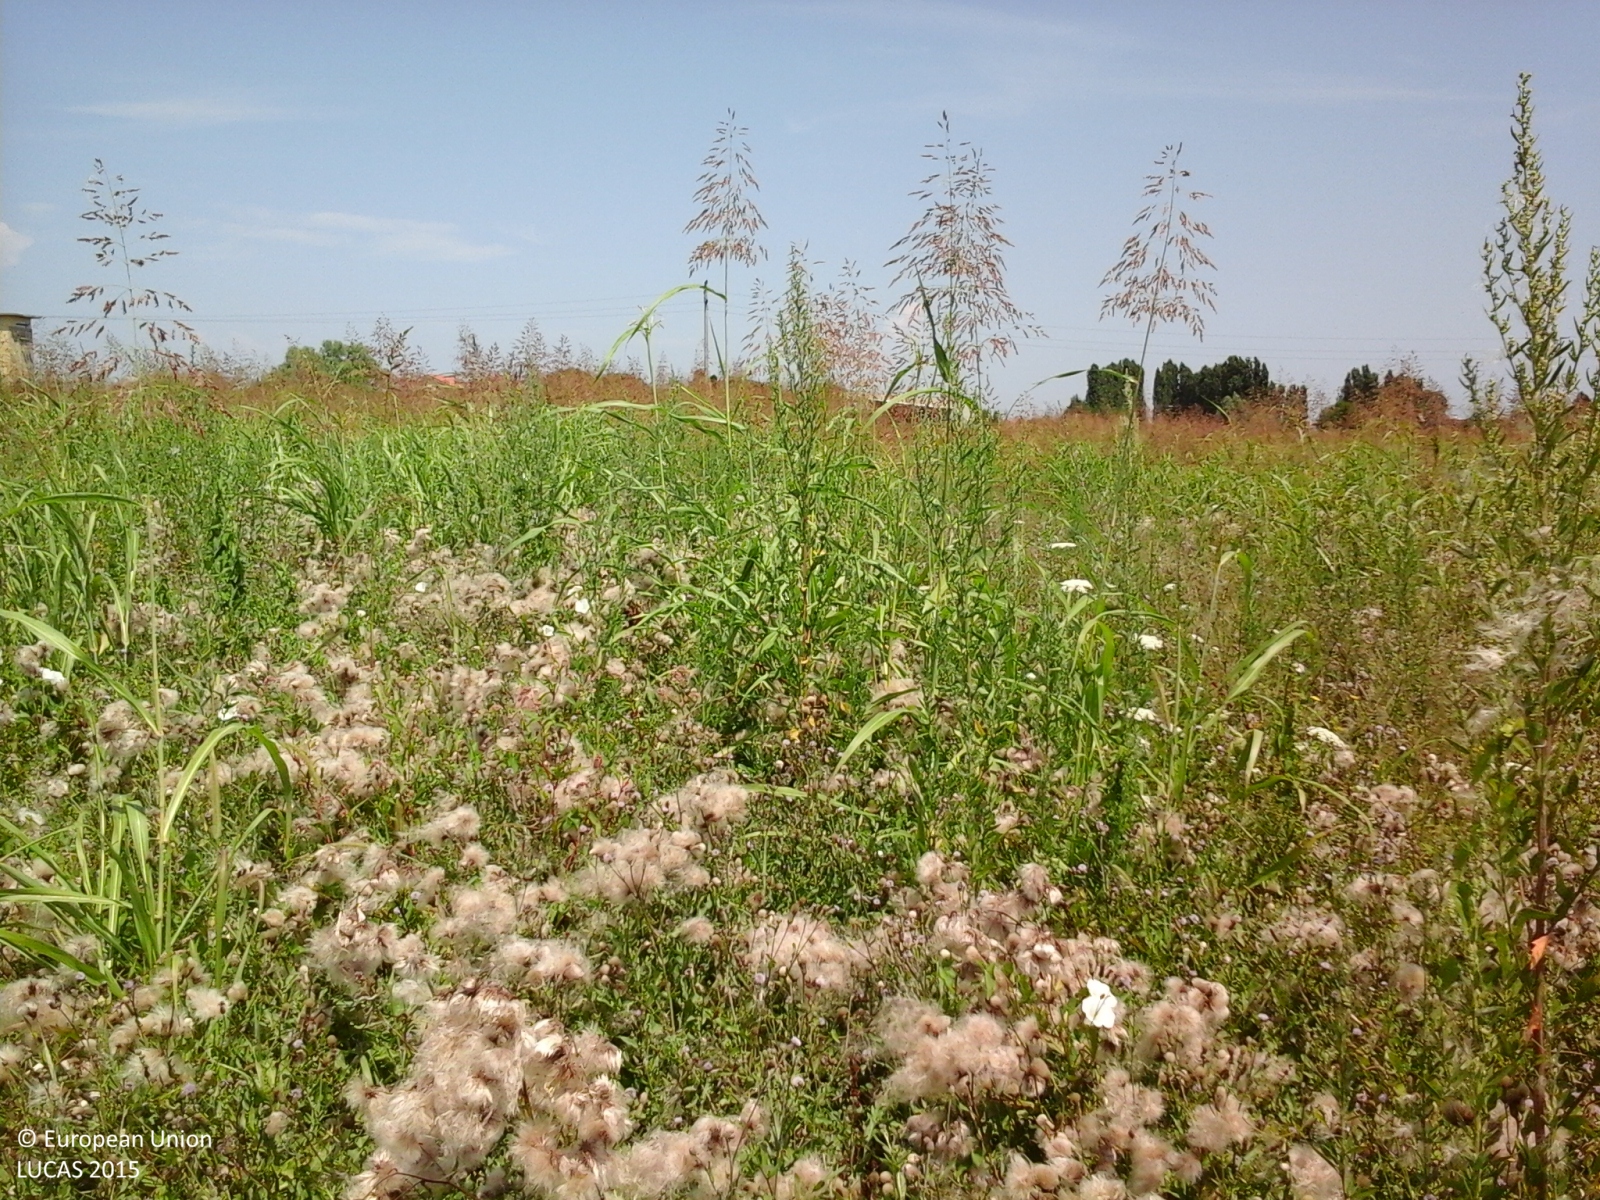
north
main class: Grassland
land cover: Spontaneously vegetated surfaces
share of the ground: > 75 %
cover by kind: herbaceous plants 100 %
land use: Fallow land
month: July
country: IT
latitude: 45.1554
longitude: 12.2730
